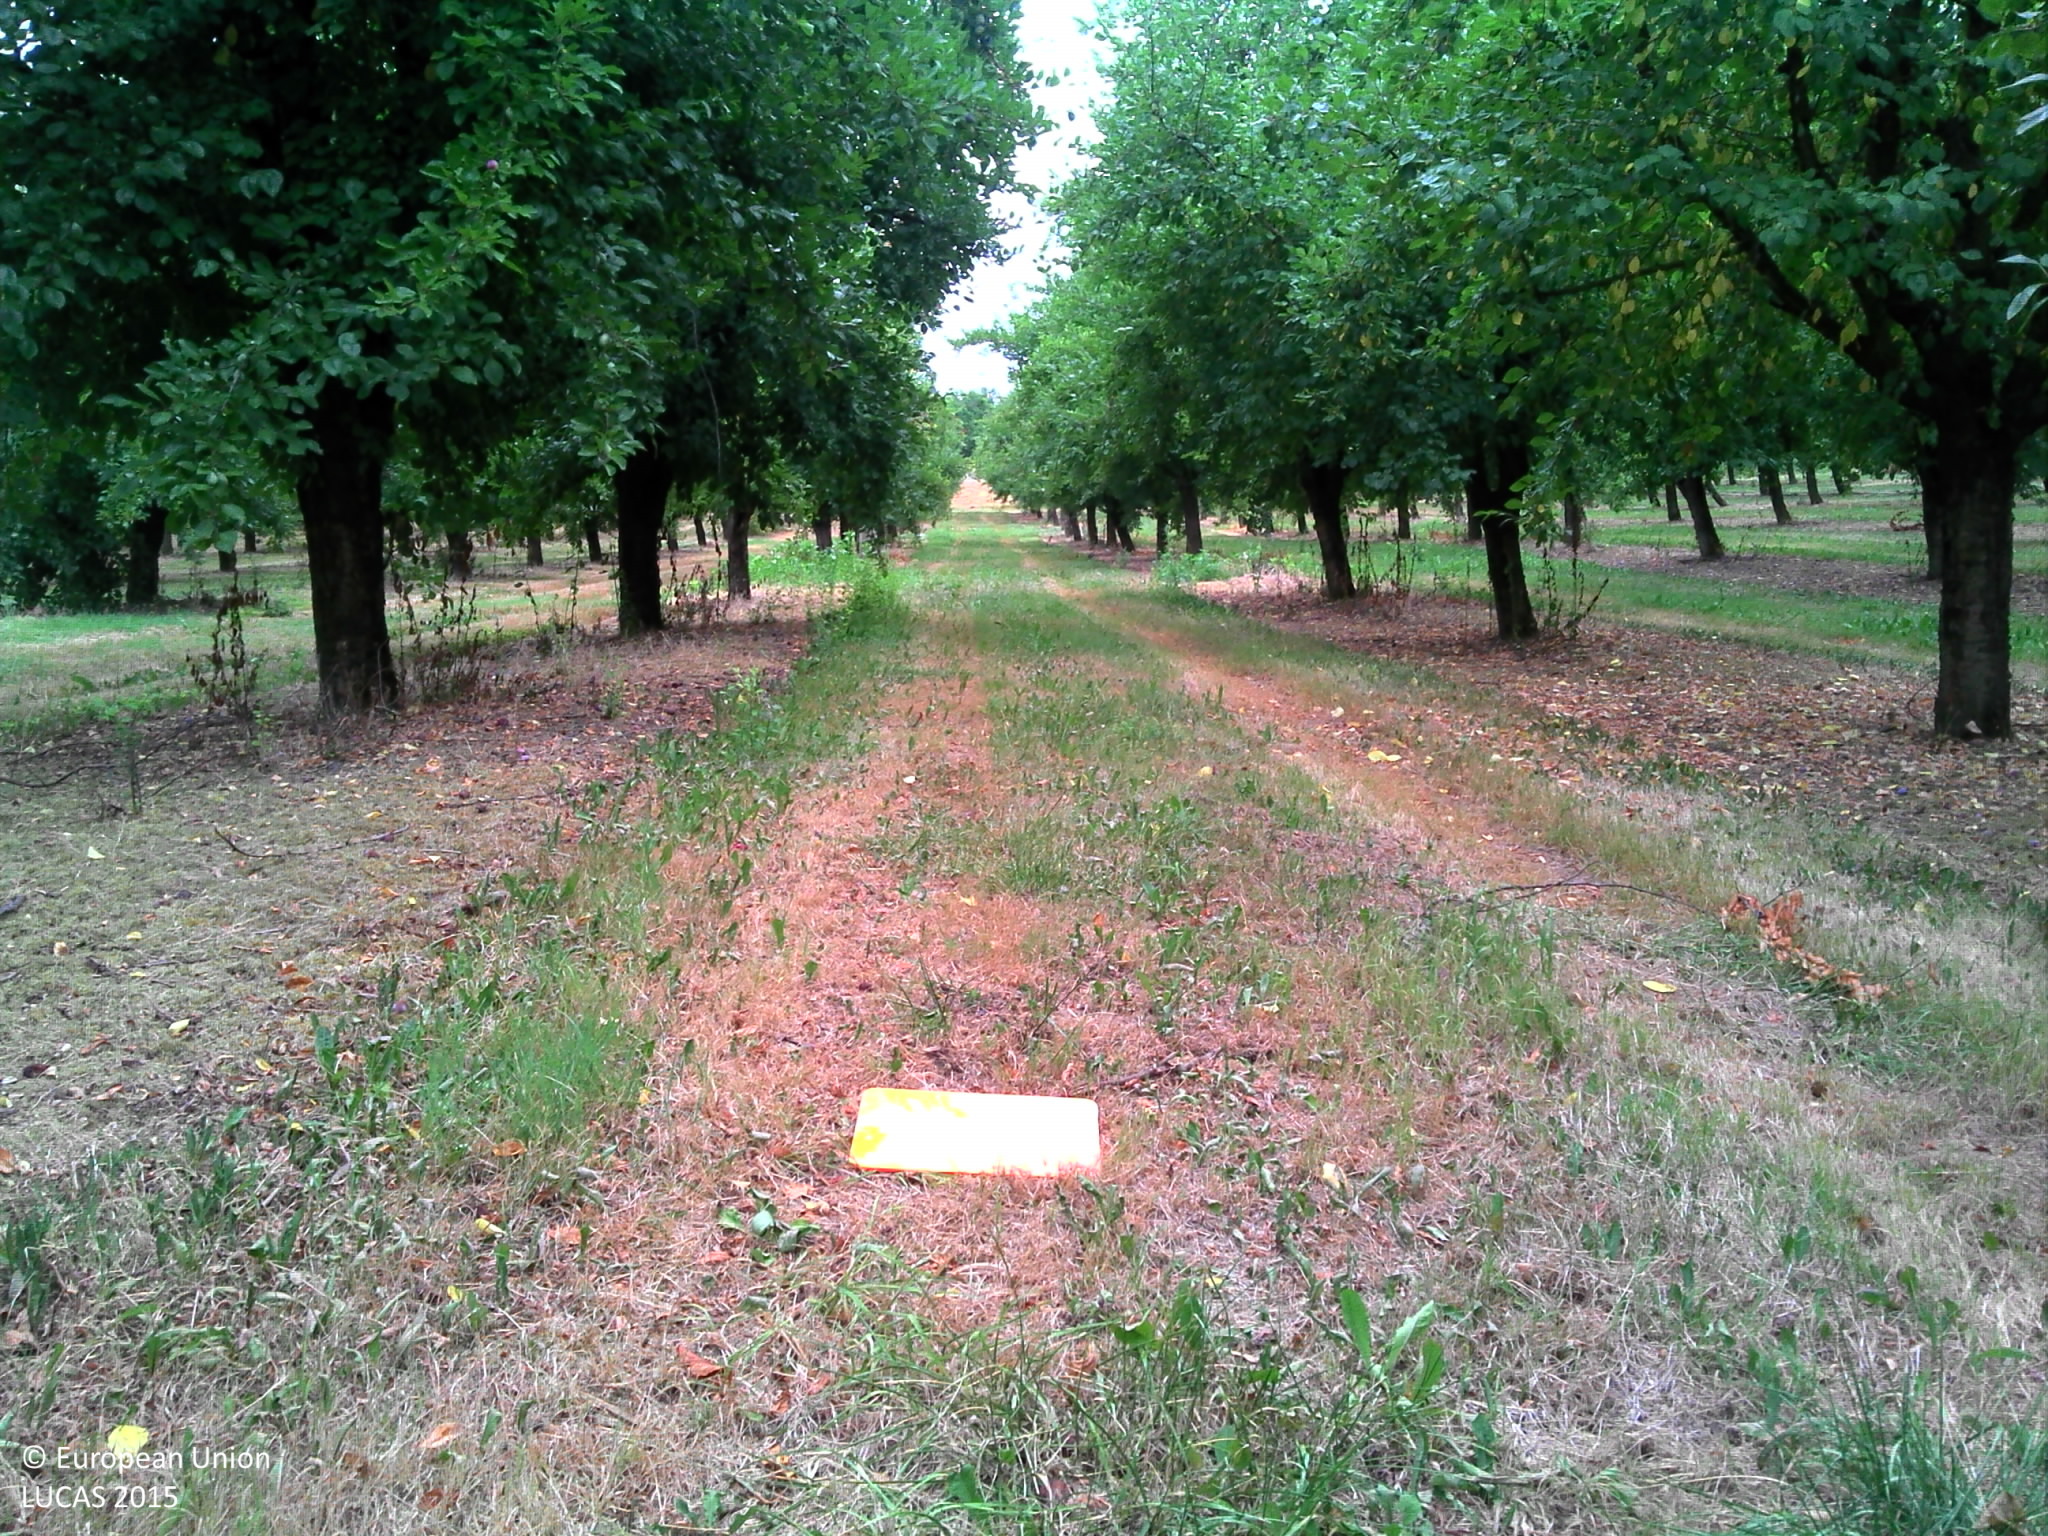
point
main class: Cropland
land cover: Other fruit trees and berries
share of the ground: 50 - 75 %
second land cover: Grassland without tree/shrub cover
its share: 25 - 50 %
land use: Agriculture (excluding fallow land and kitchen gardens)
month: July
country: FR
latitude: 44.5750
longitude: 0.5853
